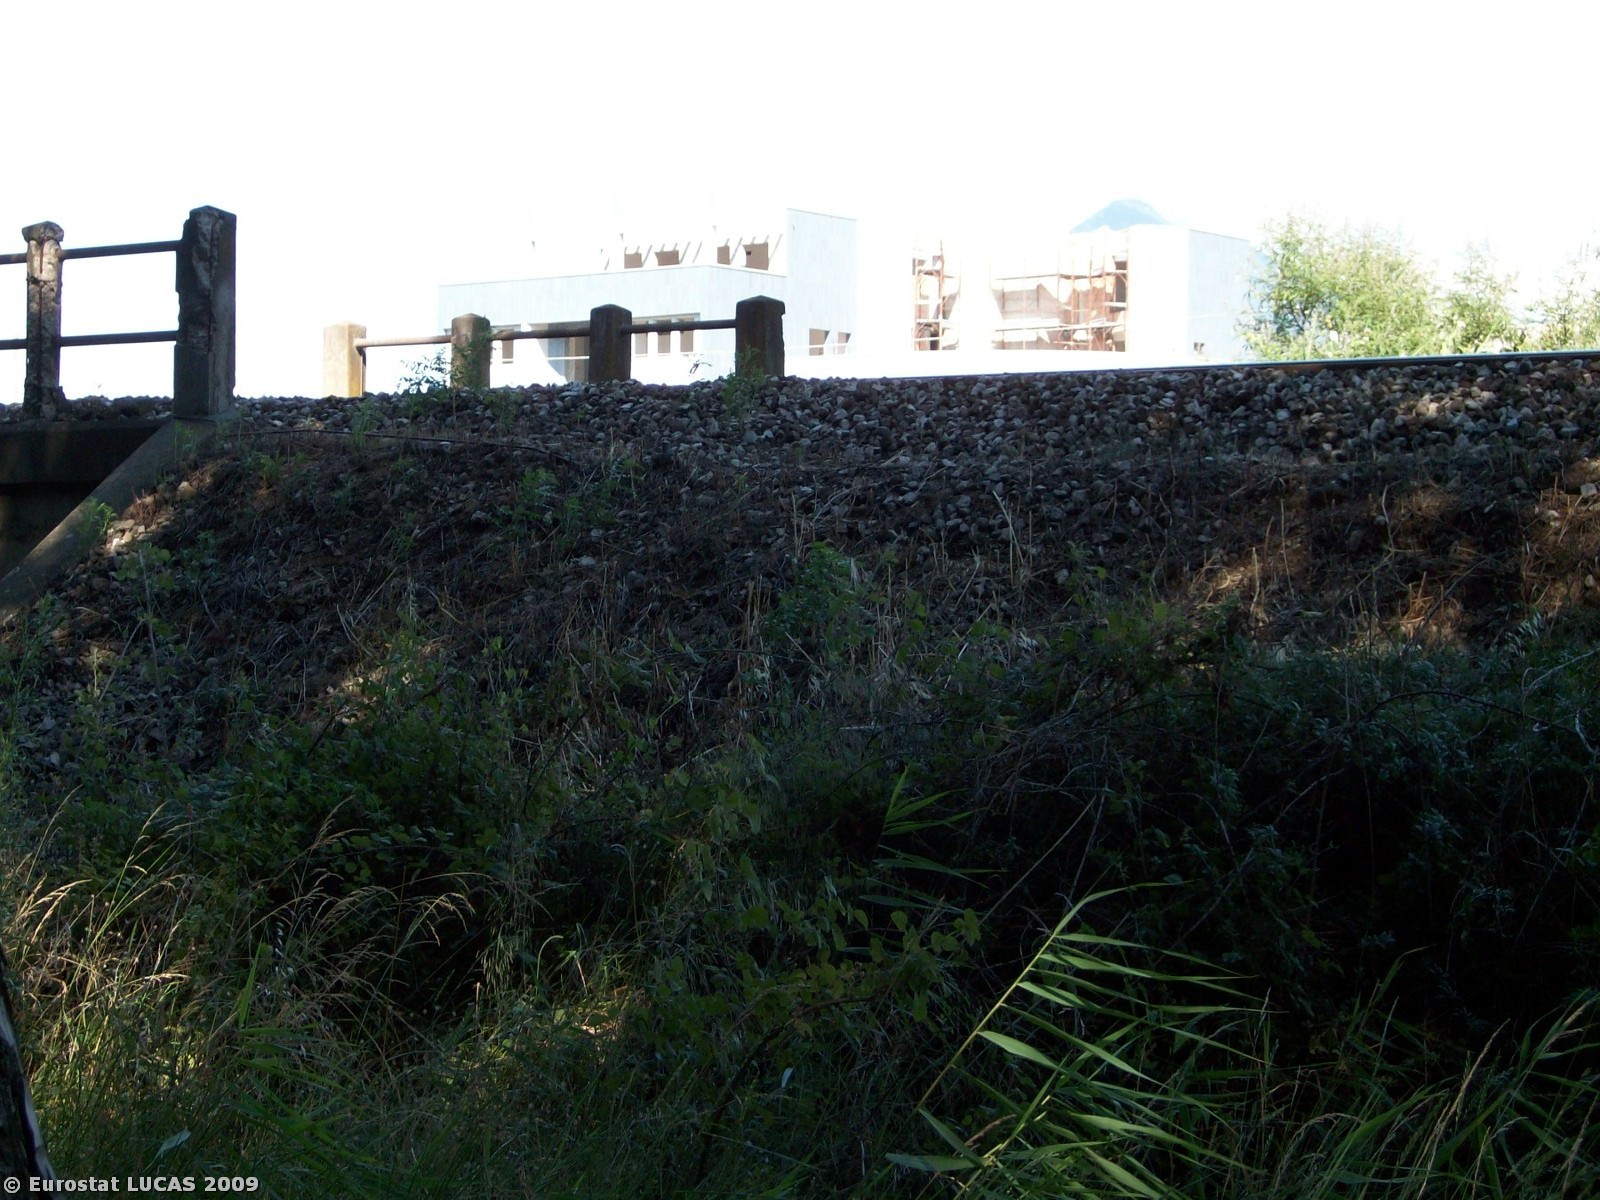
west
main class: Woodland
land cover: Coniferous woodland
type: coniferous forest of the mediterranean region
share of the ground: > 75 %
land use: Unused
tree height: > 5 m
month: June
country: IT
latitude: 39.8335
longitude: 16.5040
